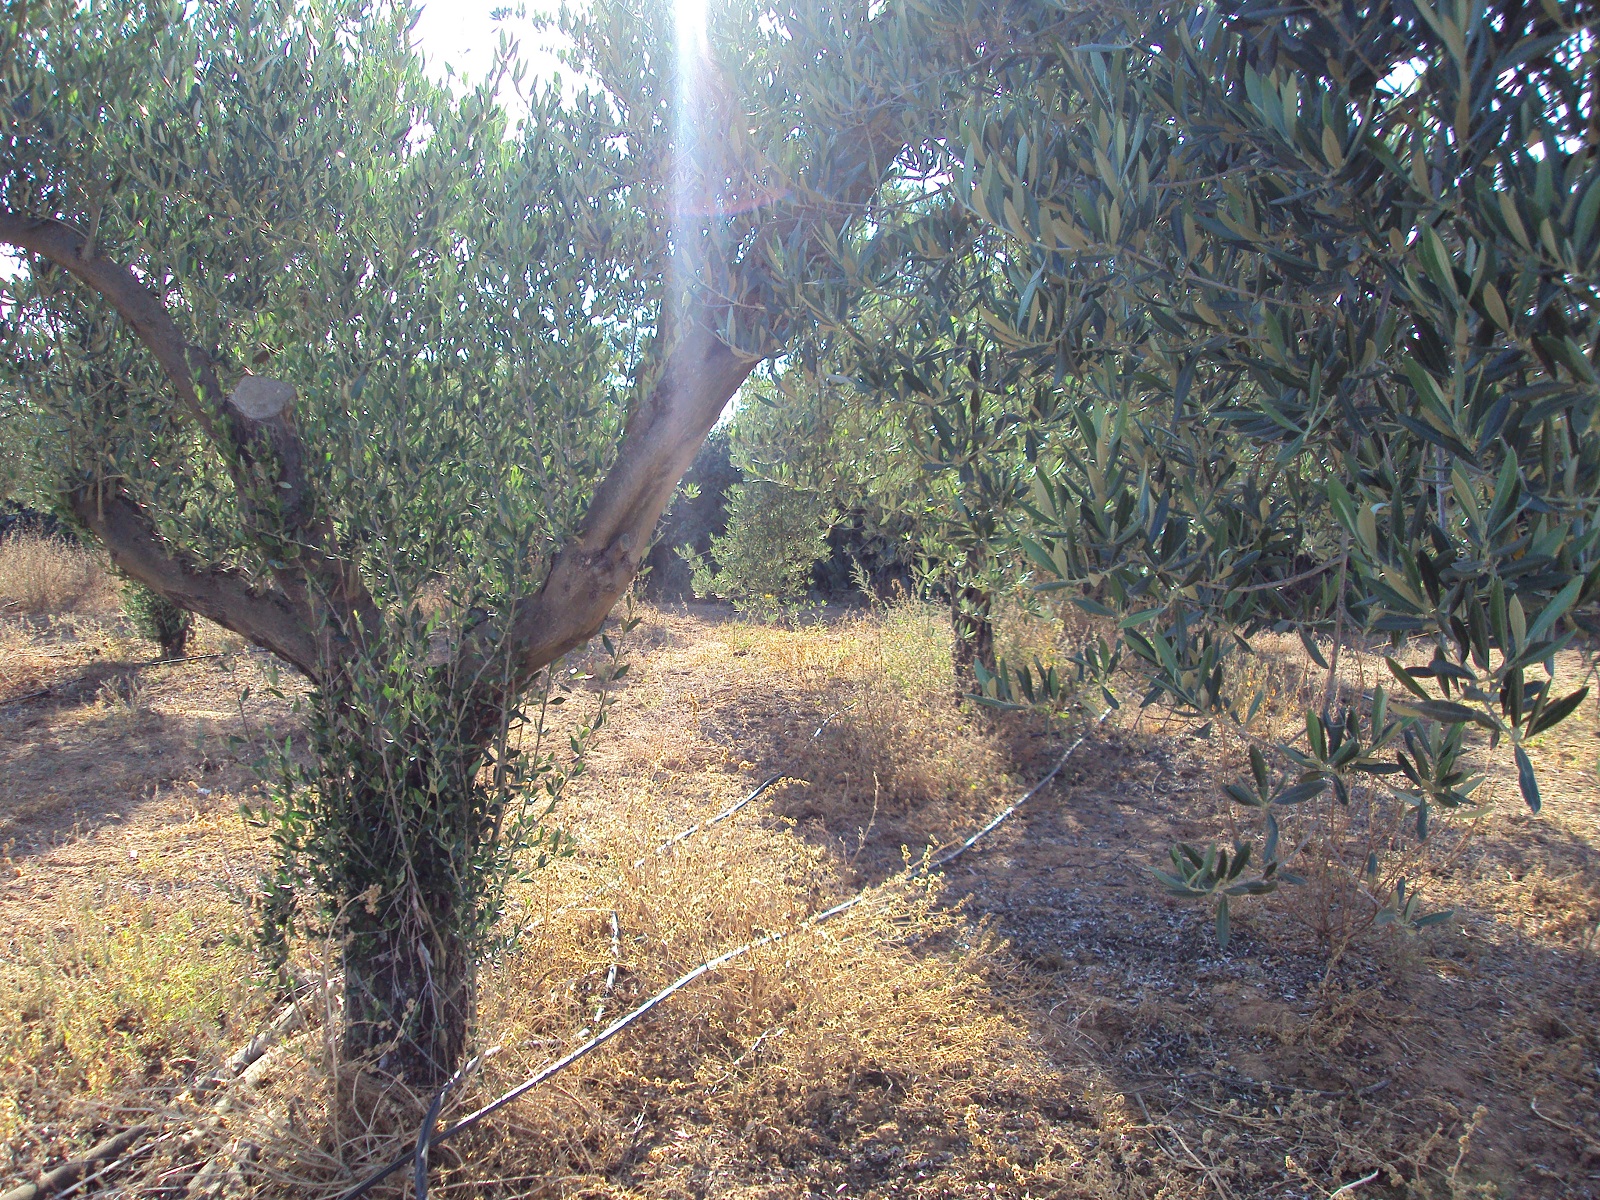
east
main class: Cropland
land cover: Olive groves
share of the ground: 50 - 75 %
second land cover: Spontaneously vegetated surfaces
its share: > 75 %
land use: Agriculture (excluding fallow land and kitchen gardens)
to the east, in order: Olive groves; Spontaneously vegetated surfaces; Abandoned hedges; Fences; Abandoned hedges; Ditches and canals; Electric lines; Tracks; Grass margins; Ditches and canals; Spontaneously vegetated surfaces; Fences; Tracks; Olive groves
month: June
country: ES
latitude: 37.3430
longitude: -6.9378
